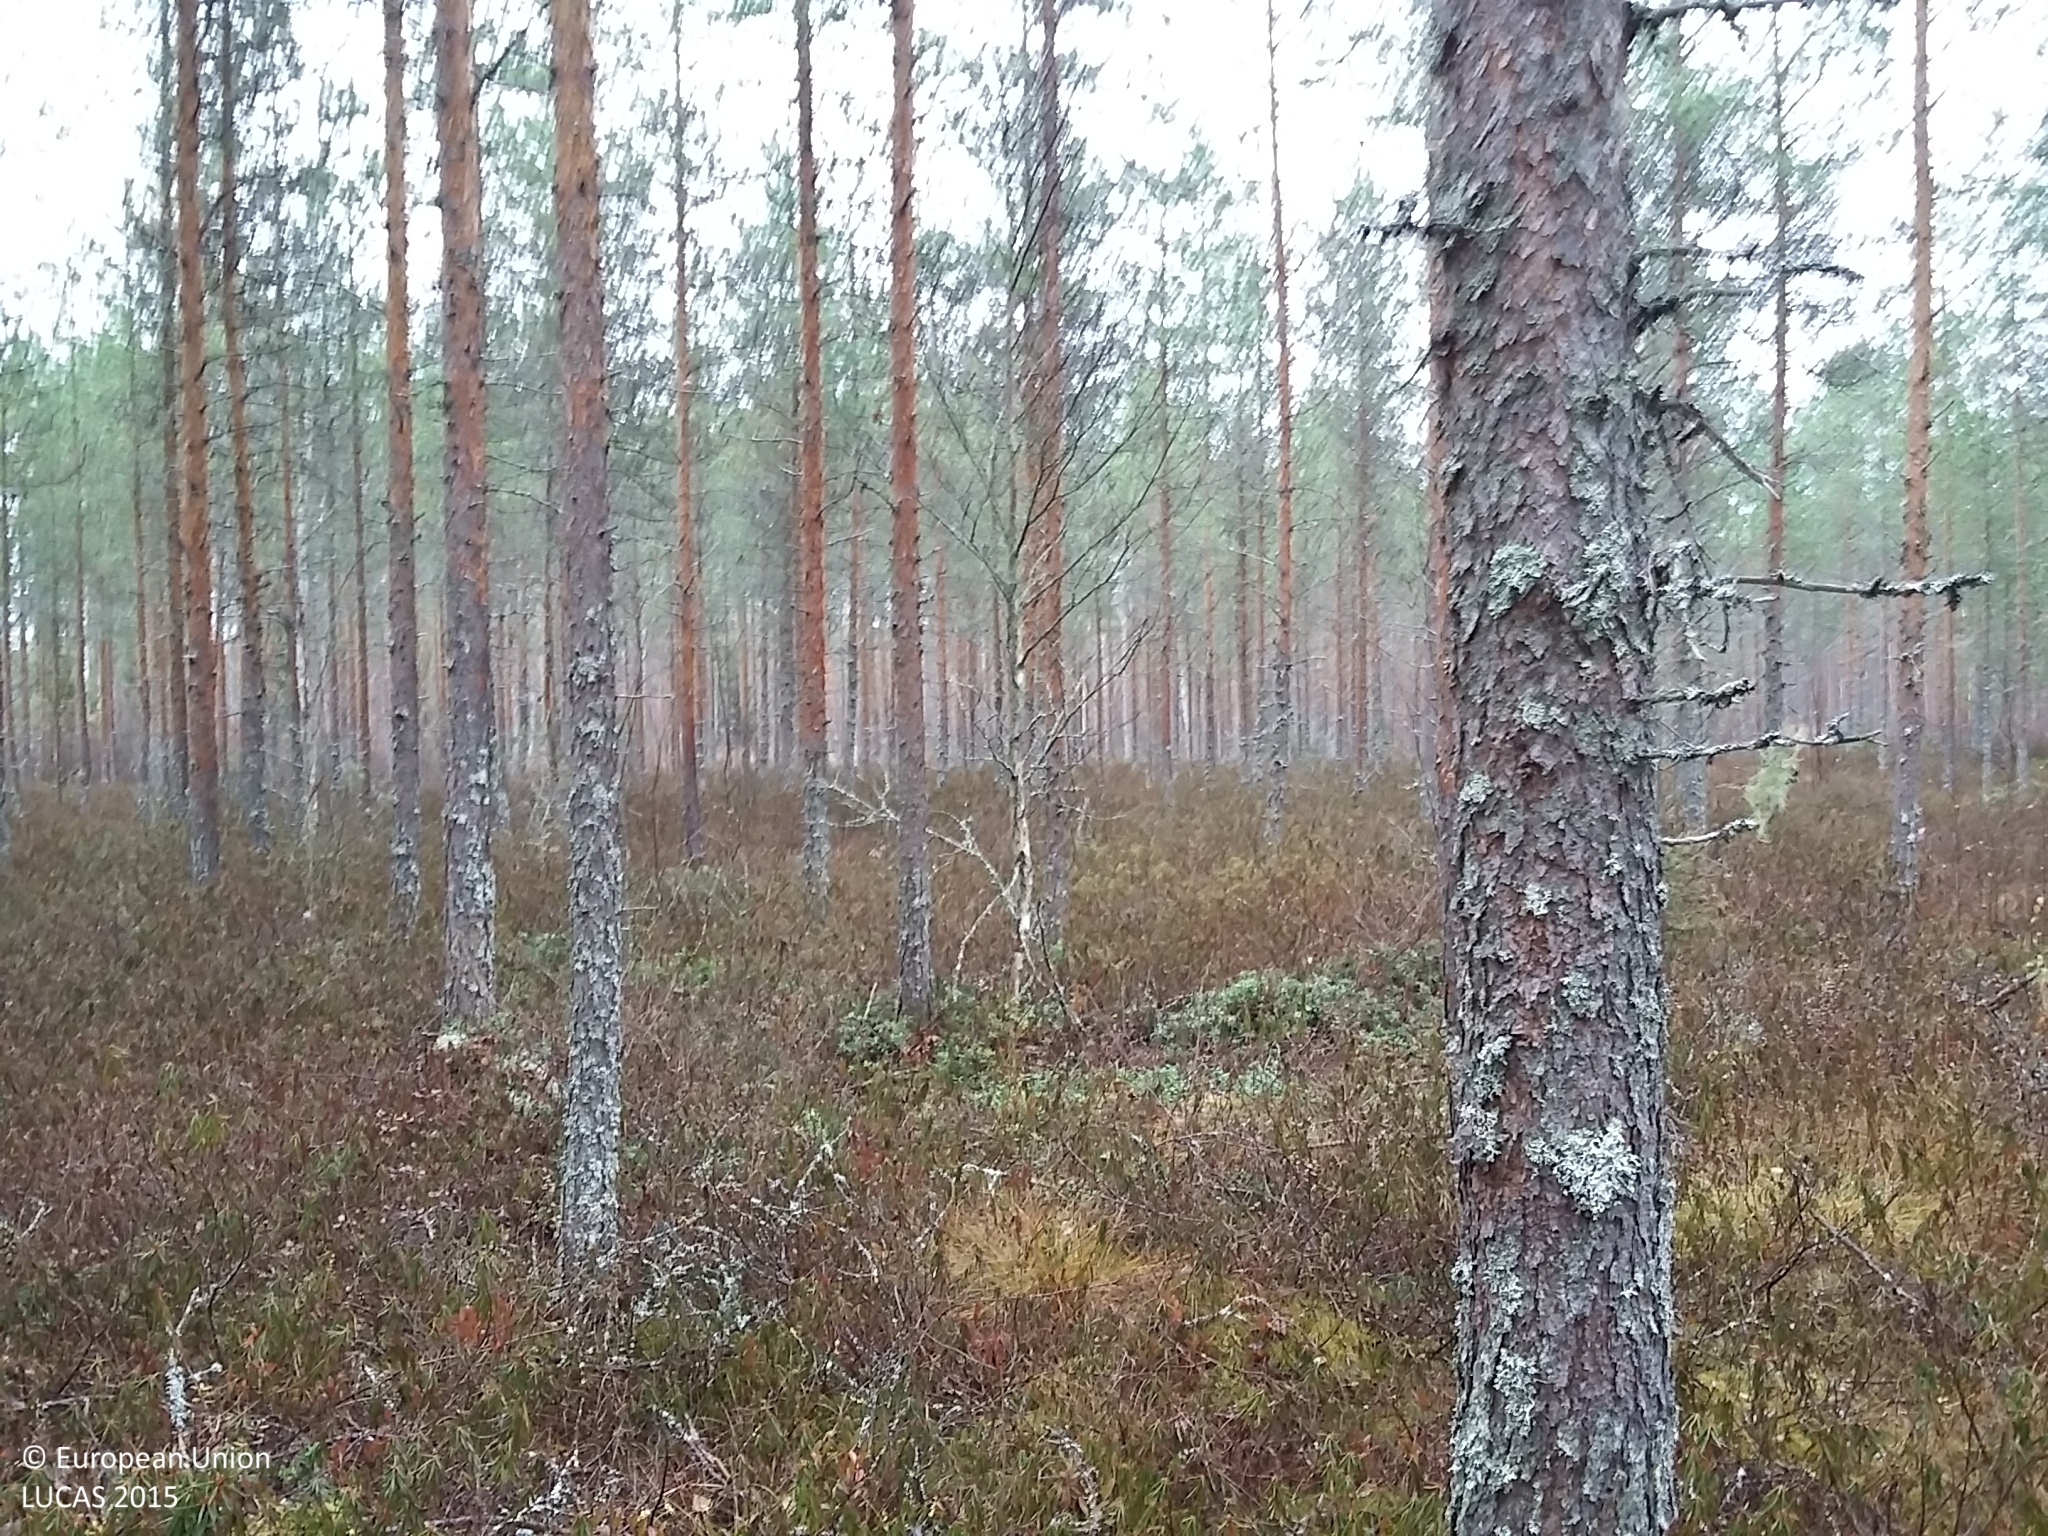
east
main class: Woodland
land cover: Pine dominated coniferous woodland
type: boreal forest
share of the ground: 50 - 75 %
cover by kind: coniferous forest trees 70 %, shrubs 20 %, lichens and mosses 10 %
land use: Forestry
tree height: > 5 m
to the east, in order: Pine dominated coniferous woodland; Other mixed woodland; Broadleaved woodland; Ditches and canals; Other mixed woodland; Ditches and canals; Broadleaved woodland; Other mixed woodland; Ditches and canals; Pine dominated mixed woodland
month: October
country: FI
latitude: 64.3999
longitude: 25.3757
